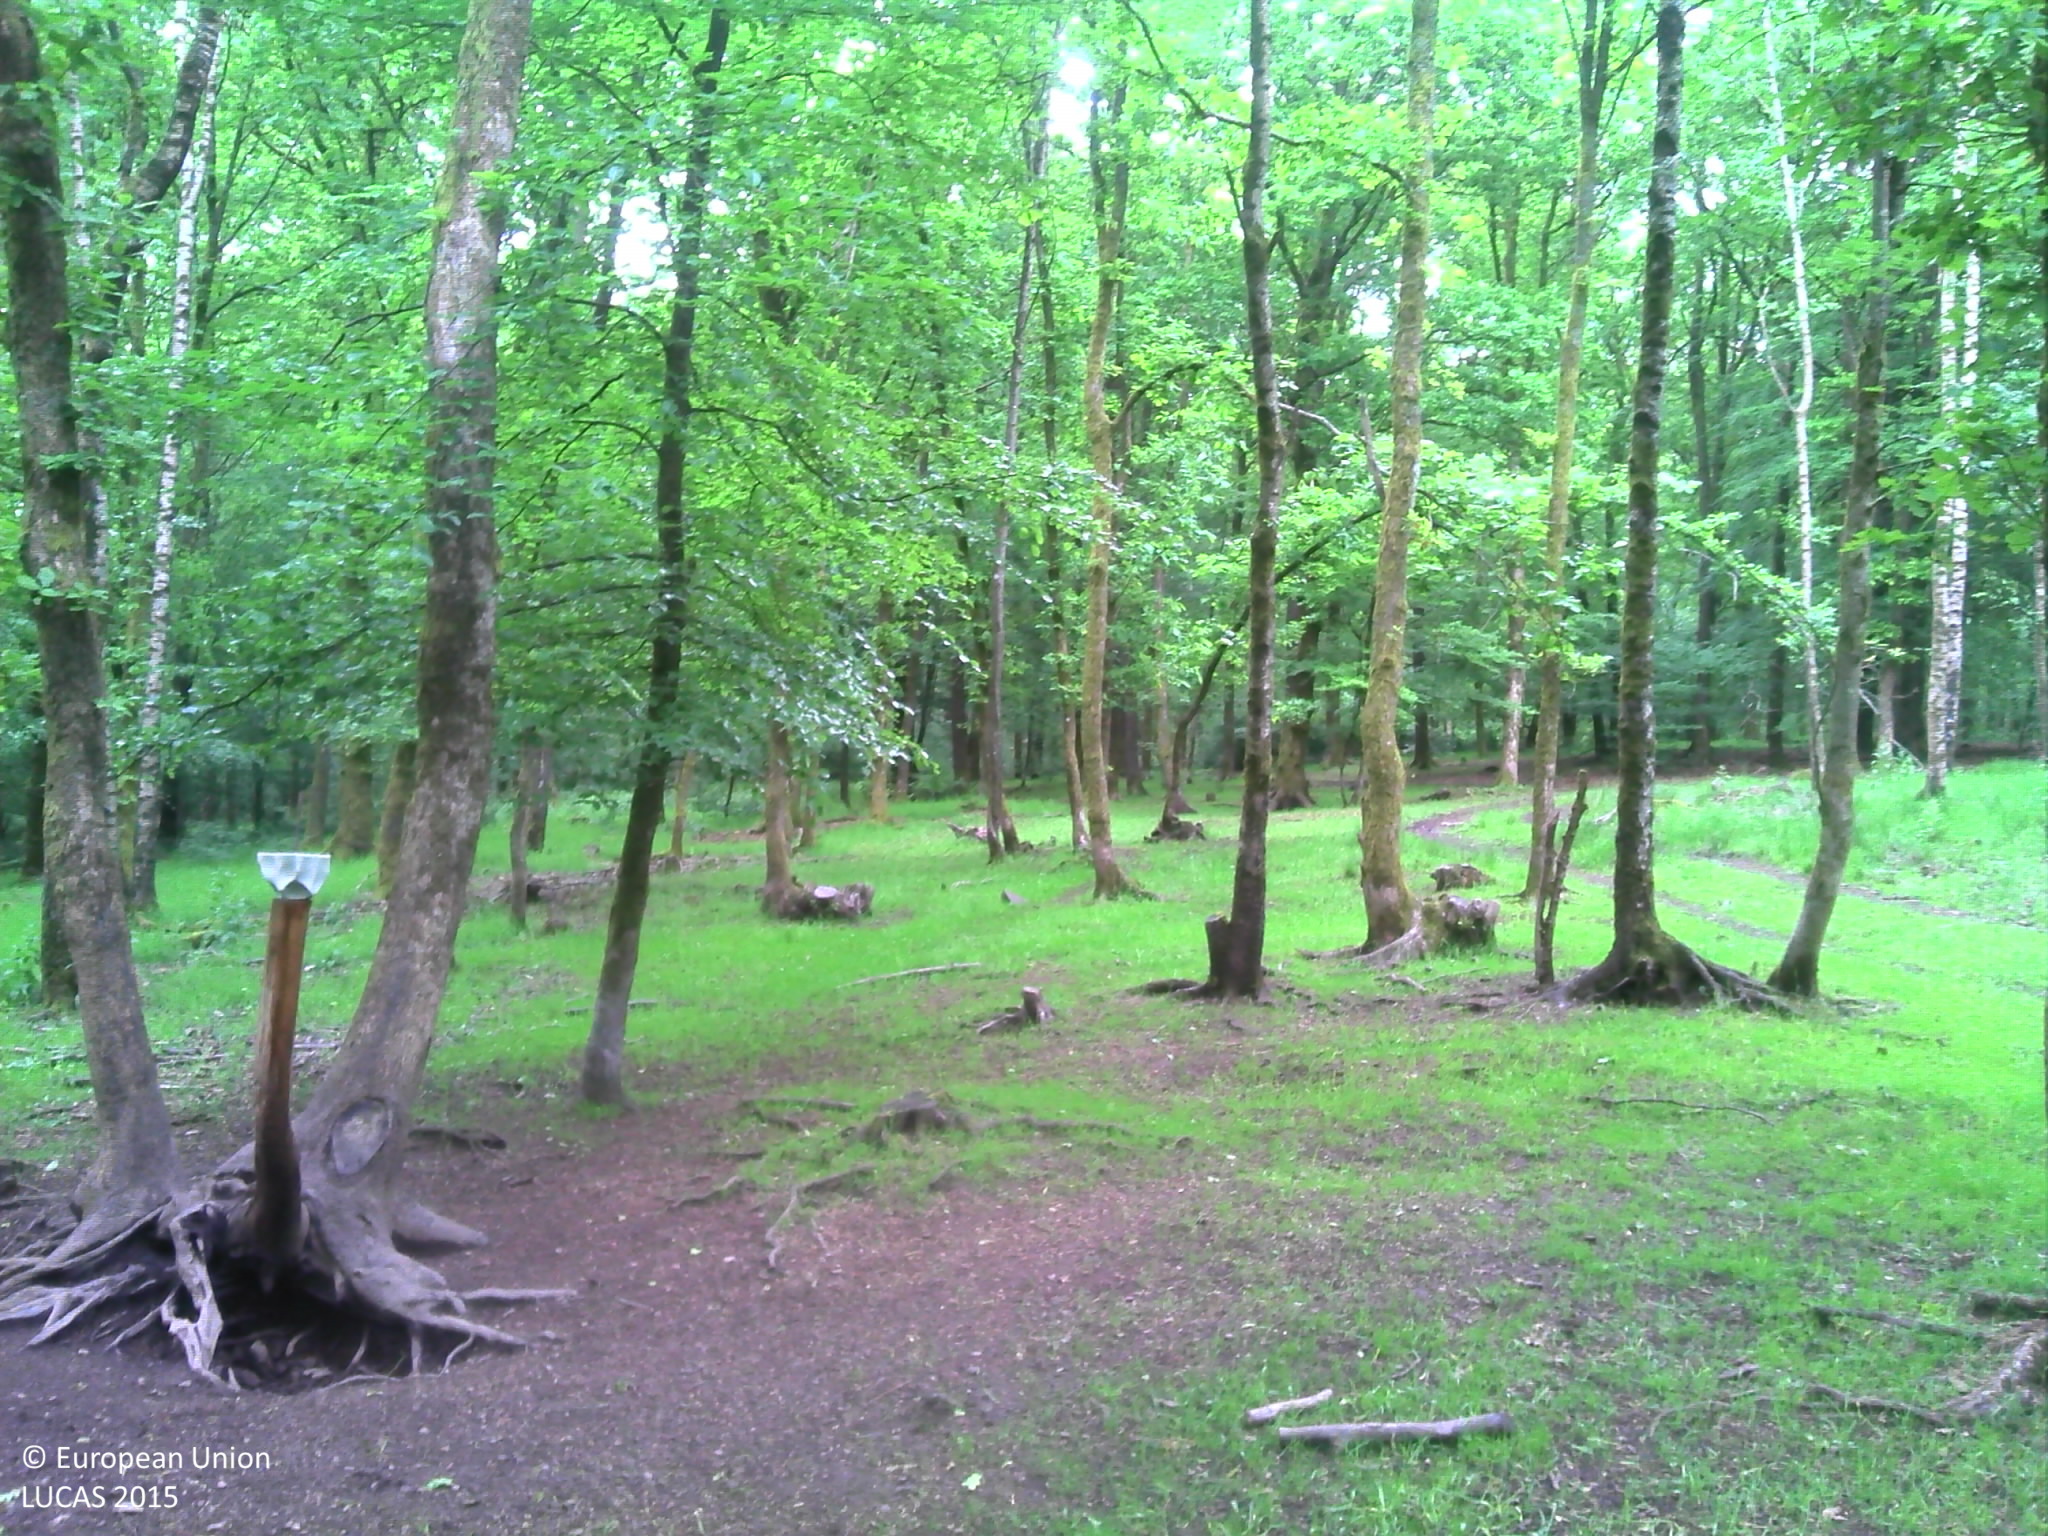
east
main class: Woodland
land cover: Broadleaved woodland
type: acidophilous oak and oak-birch forest
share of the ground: > 75 %
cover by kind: broadleaved forest trees 85 %, herbaceous plants 10 %, unconsolidated bare surface 5 %
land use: Forestry
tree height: > 5 m
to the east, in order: Broadleaved woodland; Tracks; Broadleaved woodland
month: June
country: BE
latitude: 49.8190
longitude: 4.9241
